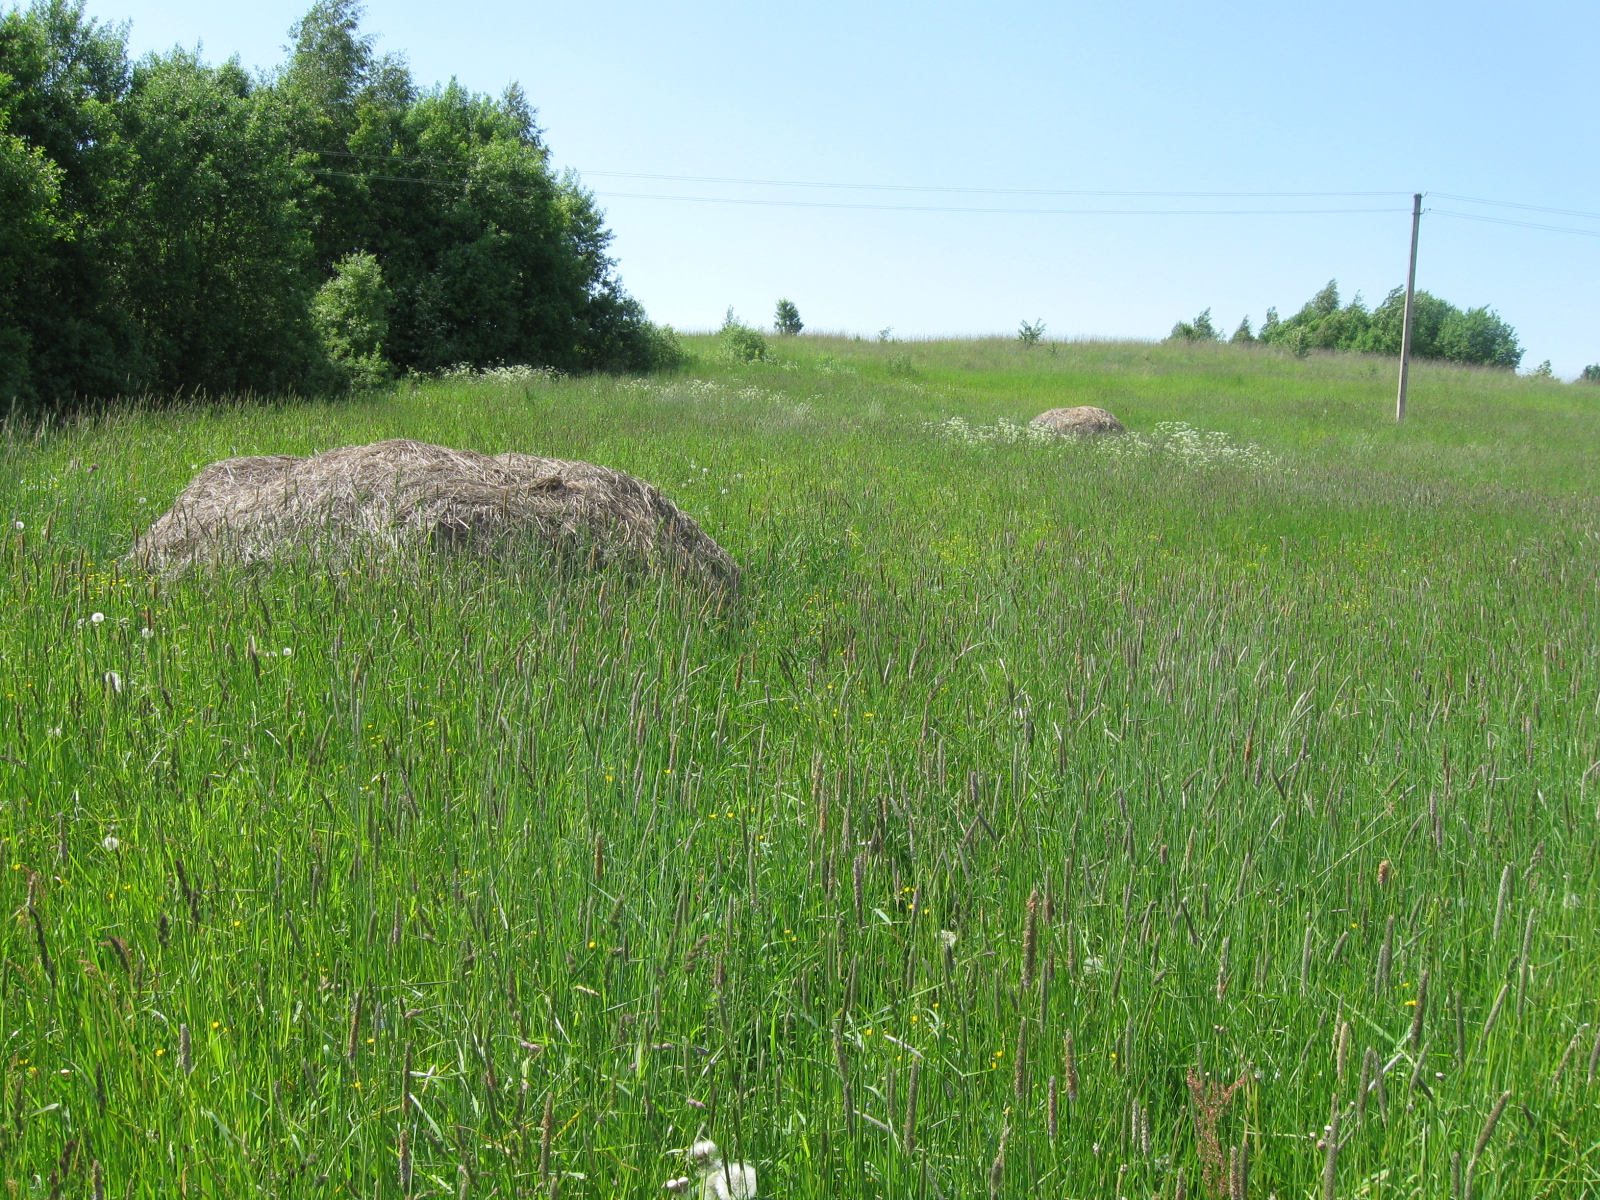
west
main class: Grassland
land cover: Grassland without tree/shrub cover
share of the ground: > 75 %
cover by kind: herbaceous plants 100 %
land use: Agriculture (excluding fallow land and kitchen gardens)
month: June
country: LT
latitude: 54.2330
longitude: 23.7882
